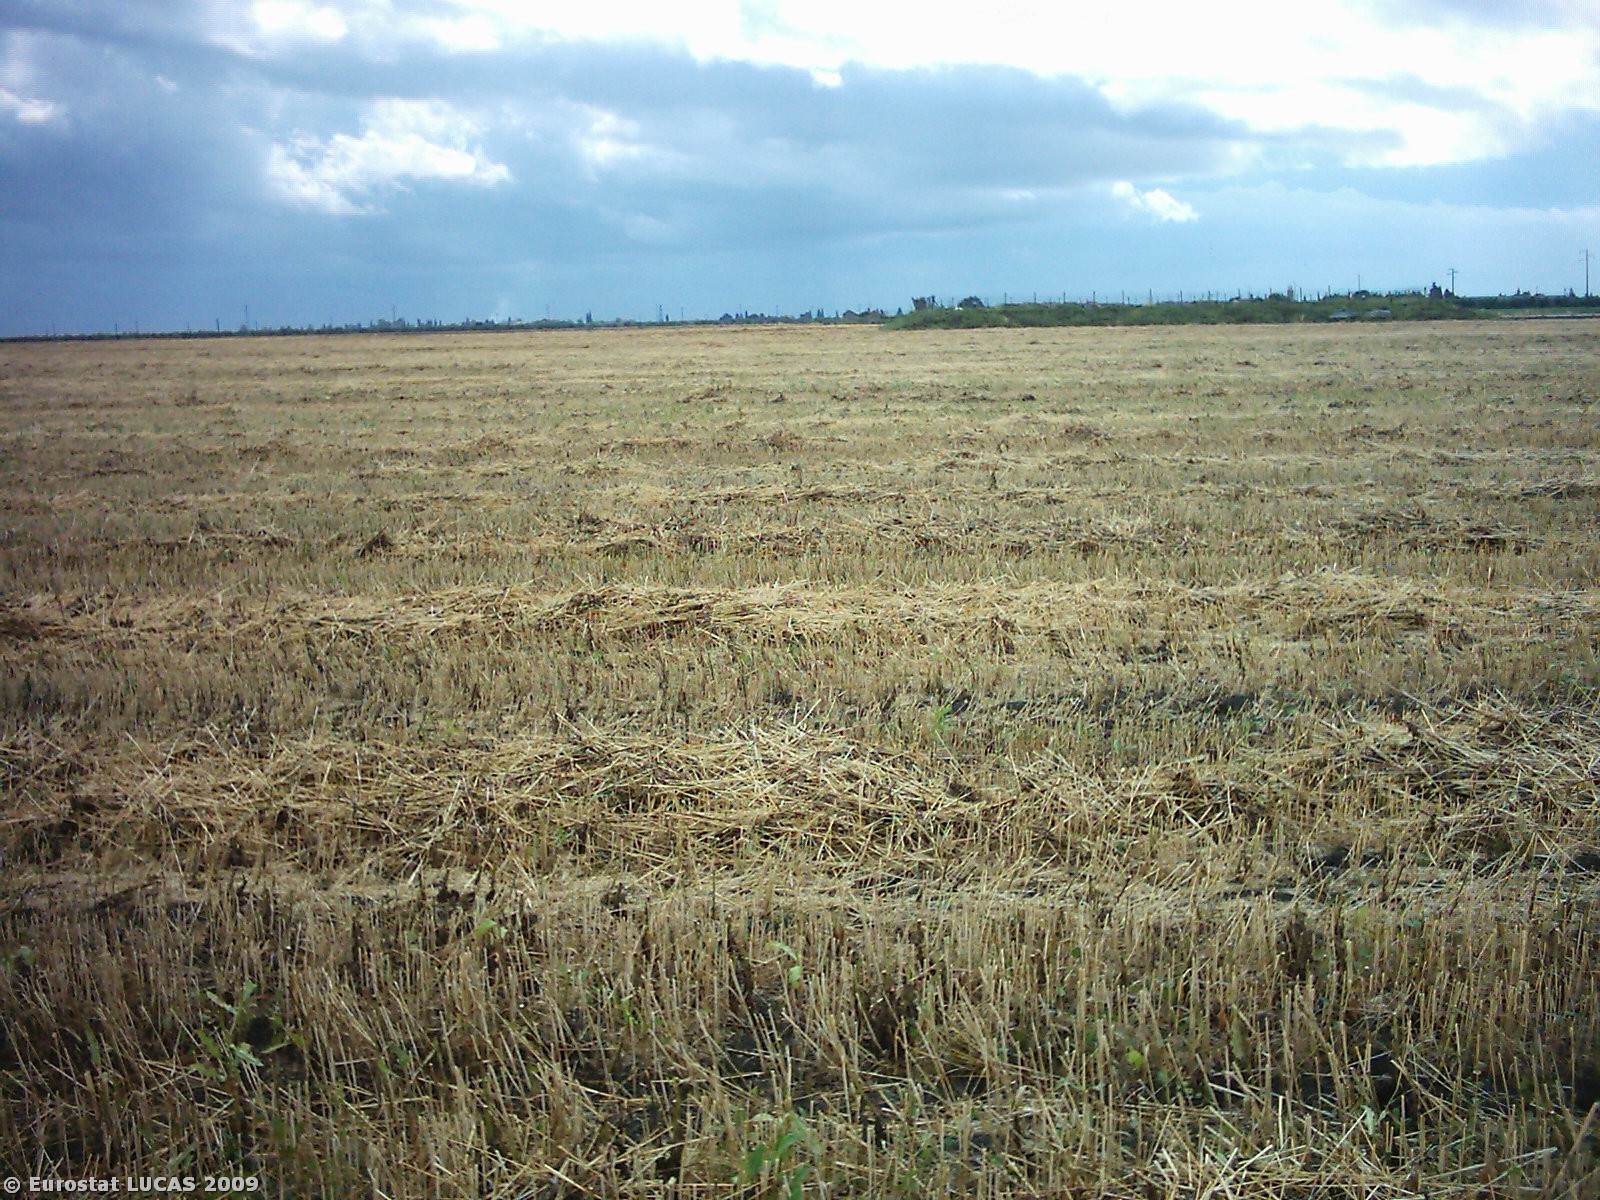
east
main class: Cropland
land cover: Durum wheat
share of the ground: > 75 %
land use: Agriculture (excluding fallow land and kitchen gardens)
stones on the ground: < 10 %
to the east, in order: Durum wheat
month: June
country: IT
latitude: 41.4256
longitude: 15.6893
